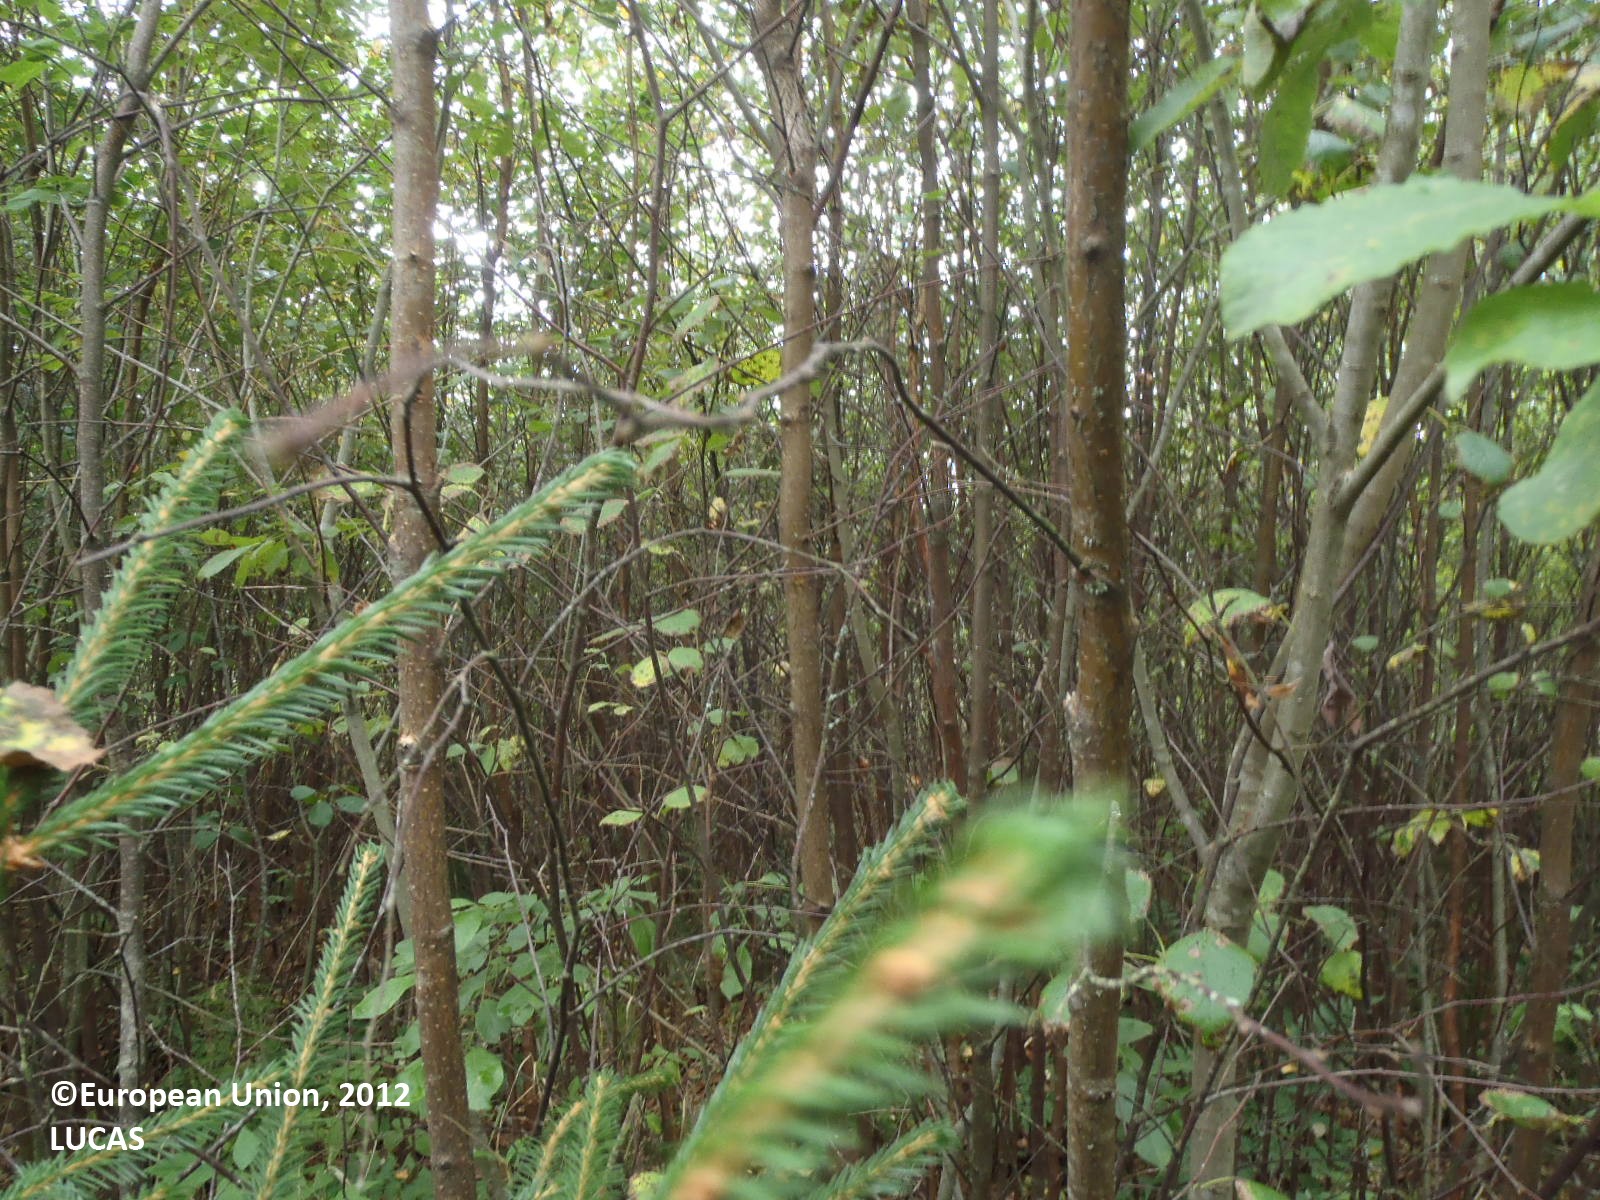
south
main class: Woodland
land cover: Broadleaved woodland
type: boreal forest
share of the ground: > 75 %
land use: Forestry
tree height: > 5 m
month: August
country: FI
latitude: 60.5971
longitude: 22.2083
